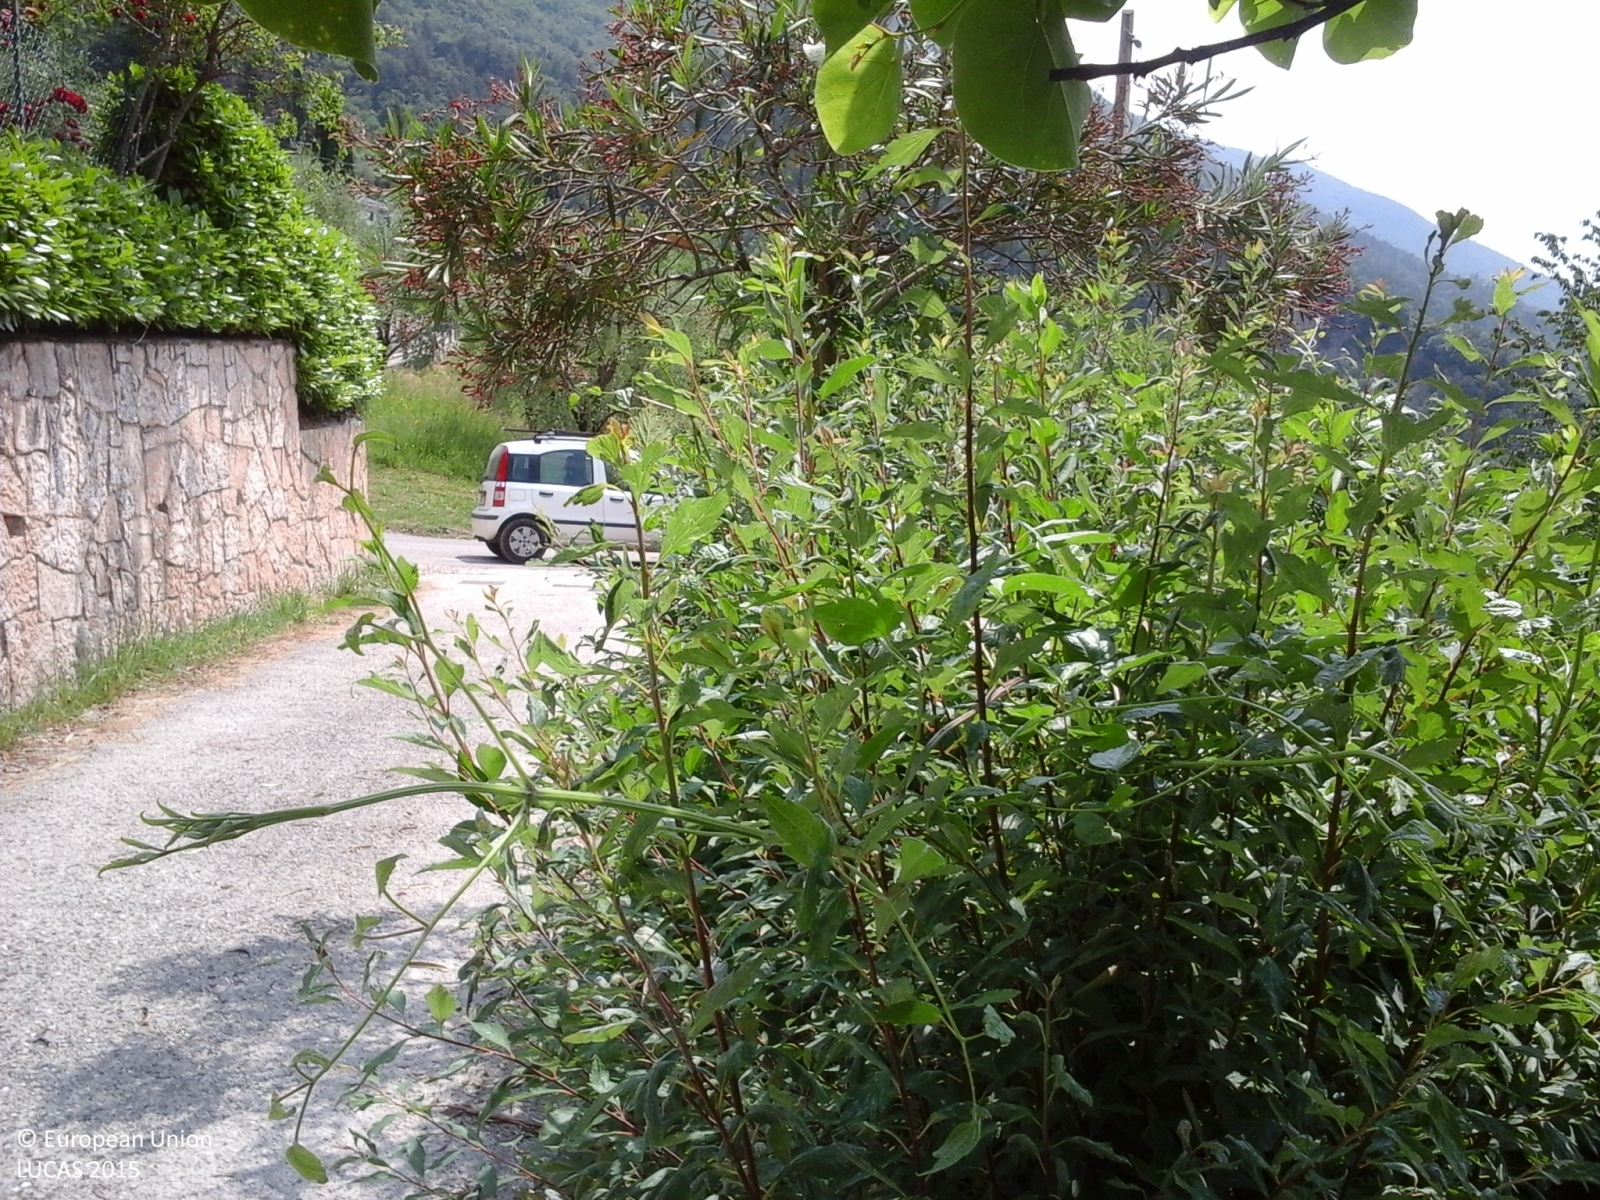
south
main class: Cropland
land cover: Olive groves
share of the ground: 50 - 75 %
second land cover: Grassland without tree/shrub cover
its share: > 75 %
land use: Agriculture (excluding fallow land and kitchen gardens)
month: June
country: IT
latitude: 45.9149
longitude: 10.9140
